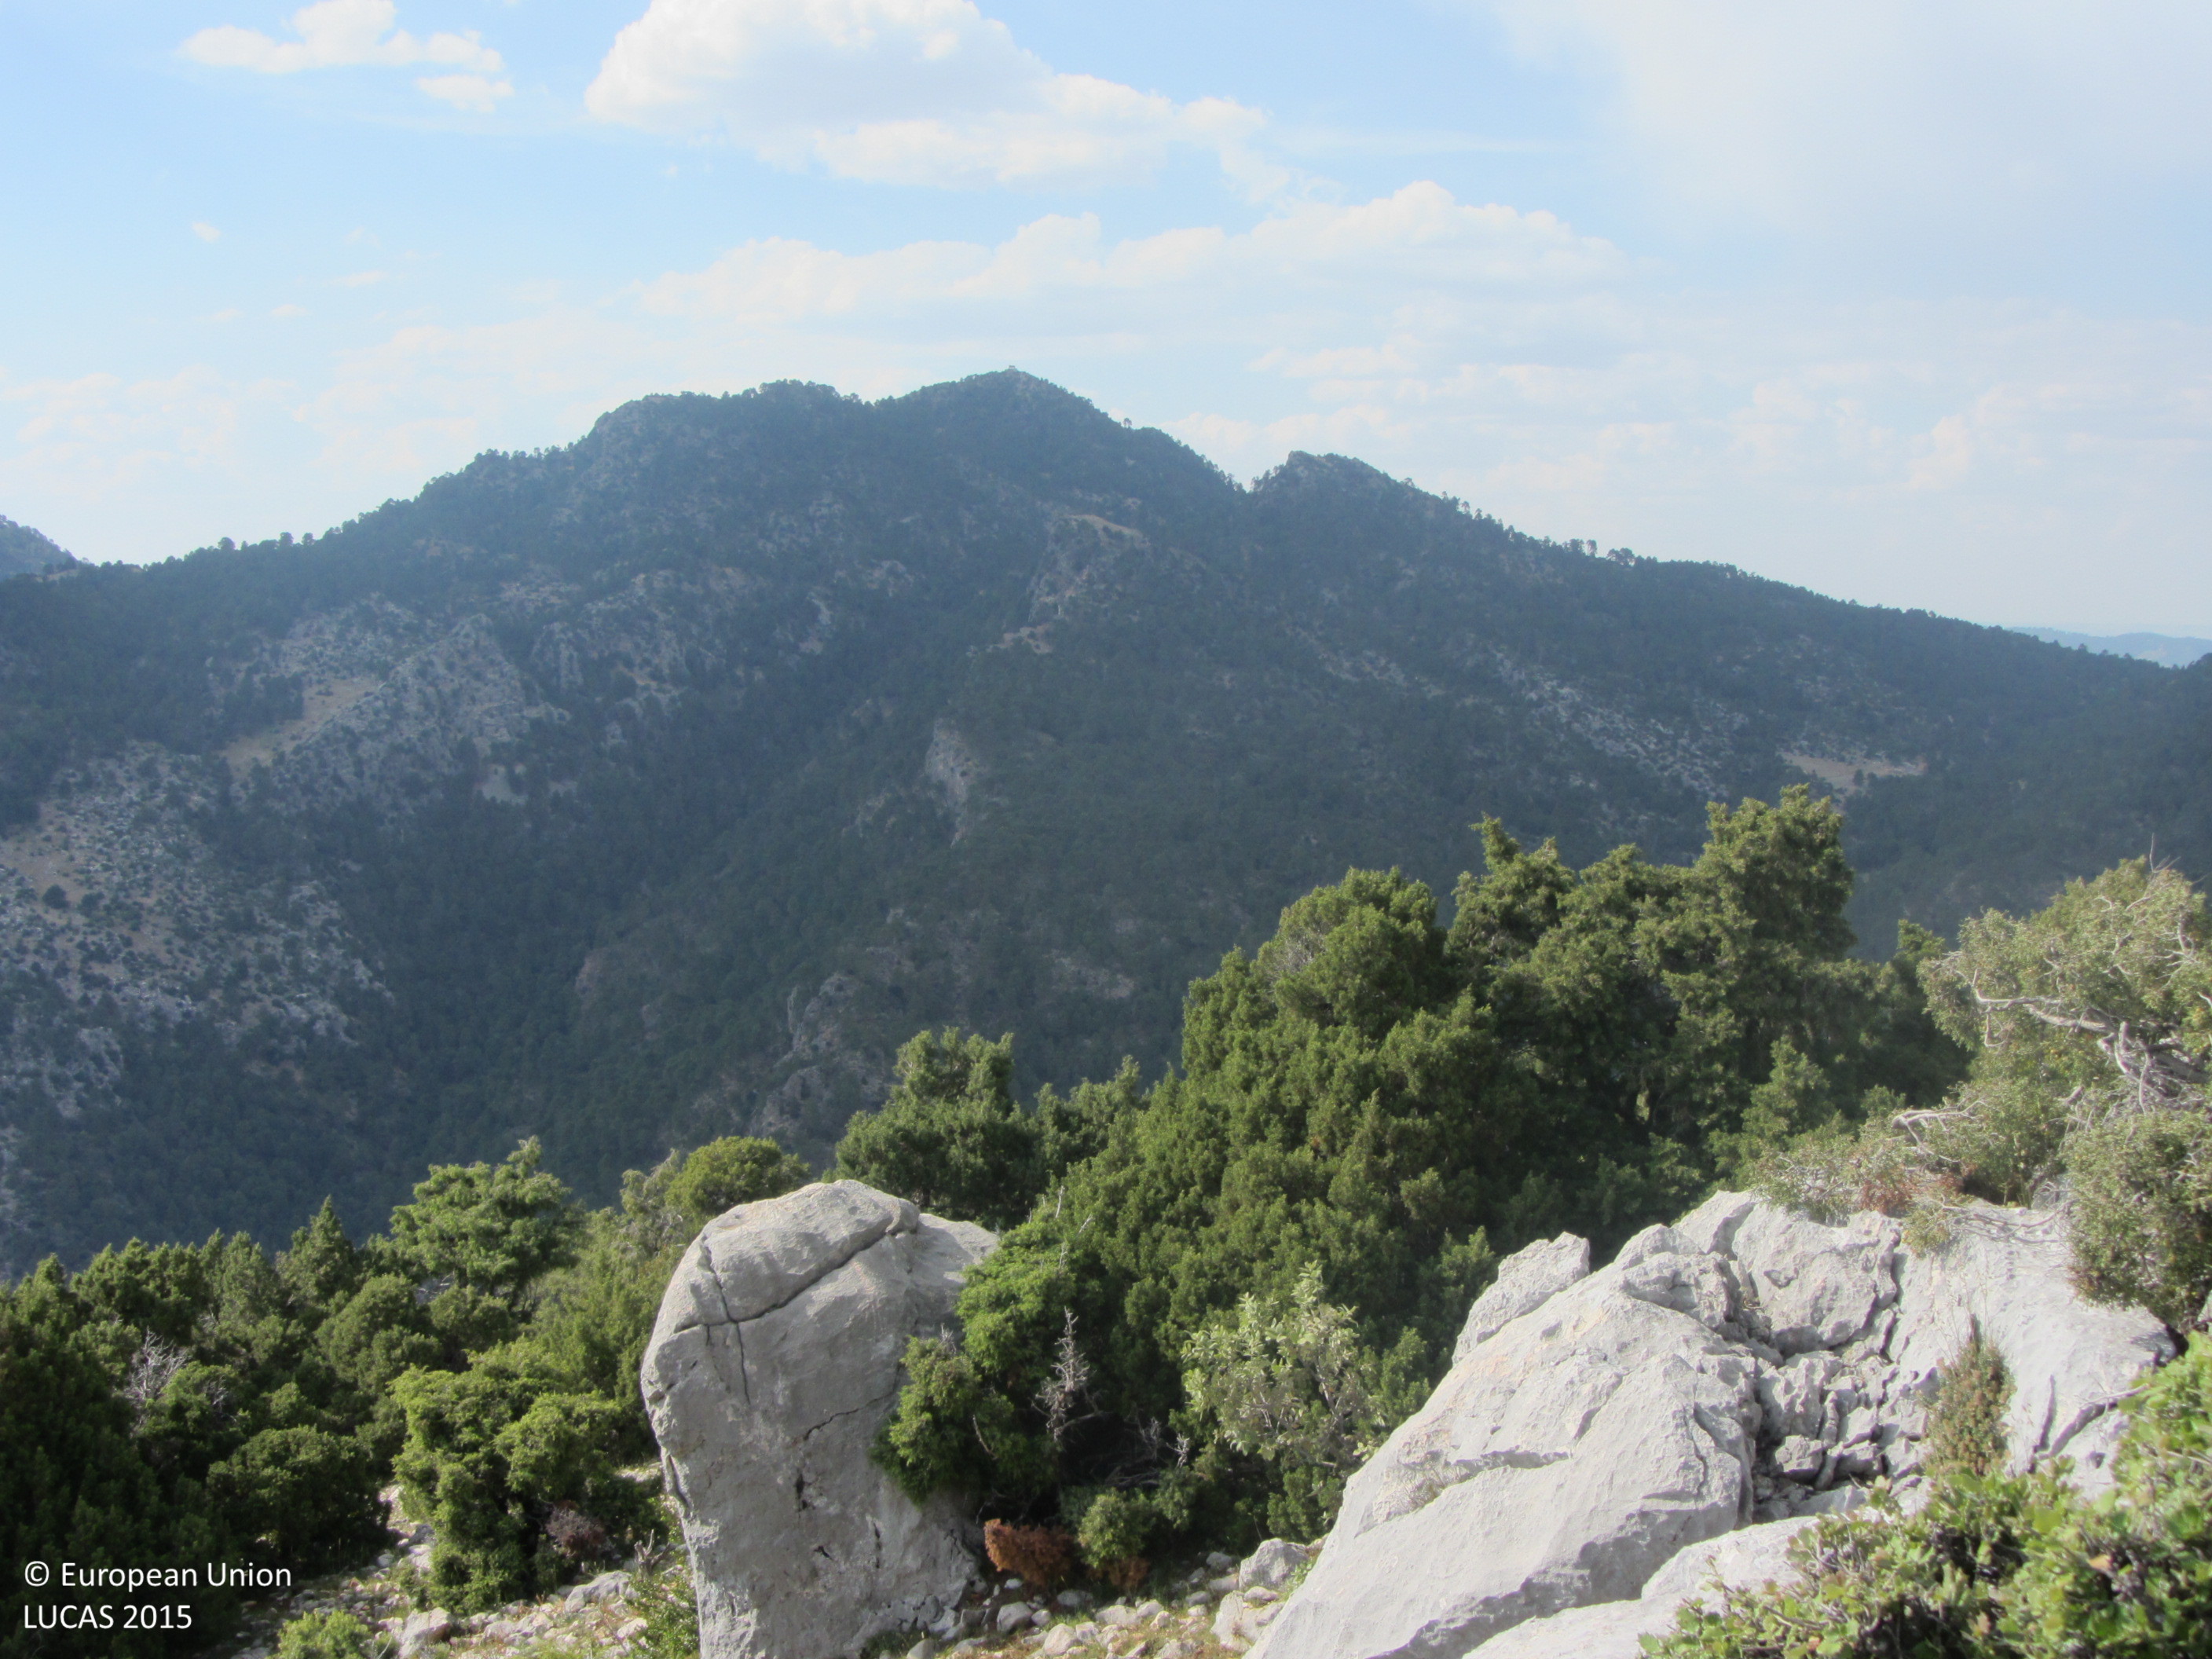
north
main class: Woodland
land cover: Pine dominated mixed woodland
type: broadleaved evergreen forest
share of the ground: 50 - 75 %
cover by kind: coniferous forest trees 40 %, broadleaved forest trees 25 %, consolidated bare surface 20 %, shrubs 15 %
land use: Semi-natural and natural areas not in use
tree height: > 5 m
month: May
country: ES
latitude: 38.0943
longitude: -2.8931
